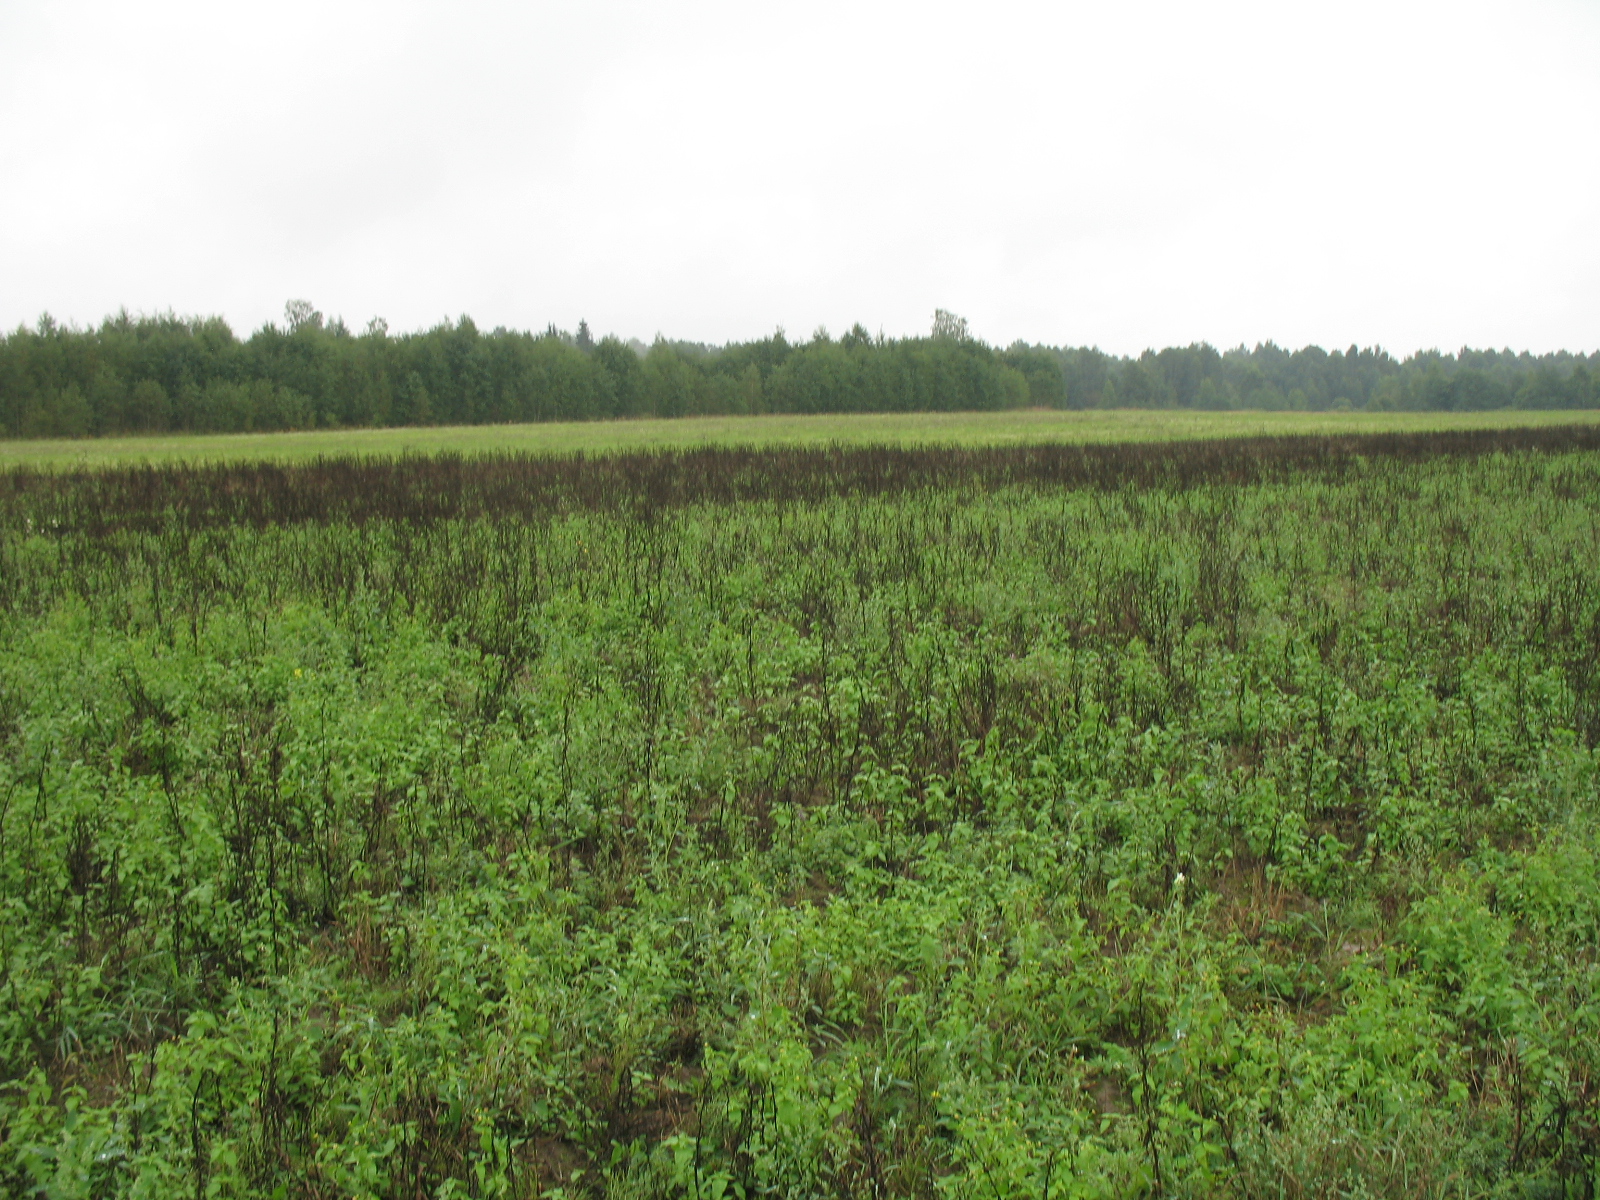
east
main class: Grassland
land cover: Spontaneously vegetated surfaces
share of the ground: > 75 %
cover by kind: herbaceous plants 80 %, unconsolidated bare surface 20 %
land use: Fallow land
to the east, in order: Spontaneously vegetated surfaces; Fences; Grassland without tree/shrub cover; Fences; Broadleaved woodland; Spontaneously vegetated surfaces; Broadleaved woodland; Spontaneously vegetated surfaces; Broadleaved woodland
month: September
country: LV
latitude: 56.0822
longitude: 26.2268
